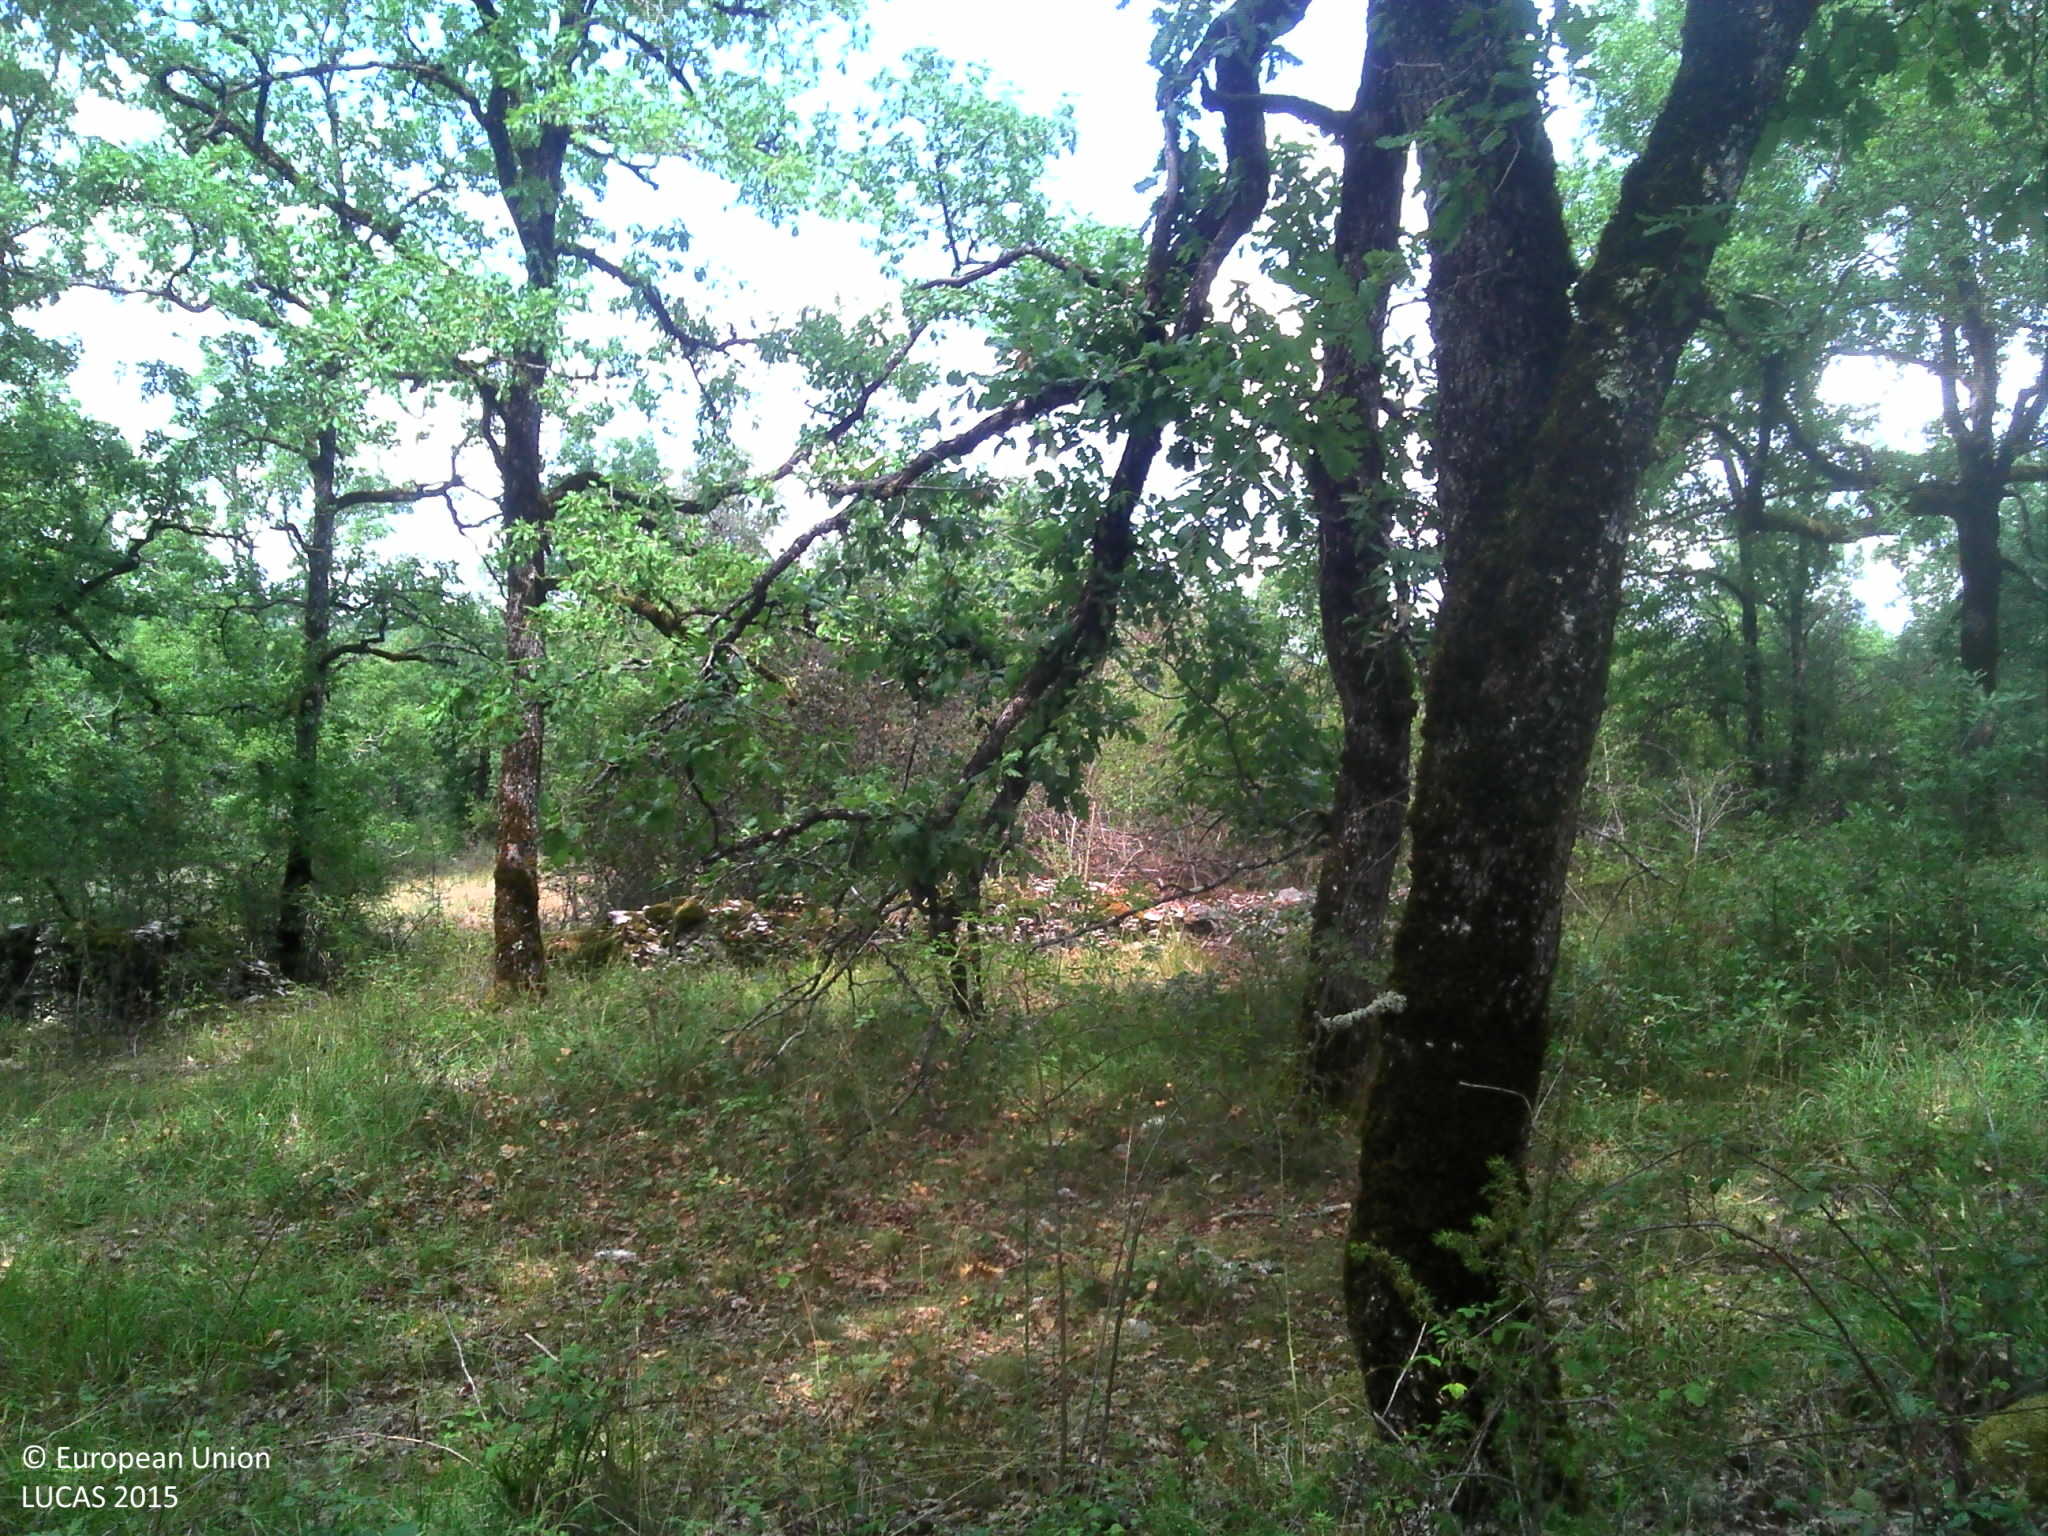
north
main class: Woodland
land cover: Broadleaved woodland
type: thermophilous deciduous forest
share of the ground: > 75 %
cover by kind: broadleaved forest trees 80 %, shrubs 10 %, herbaceous plants 10 %
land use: Forestry
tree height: > 5 m
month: August
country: FR
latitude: 44.8579
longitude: 1.7851
